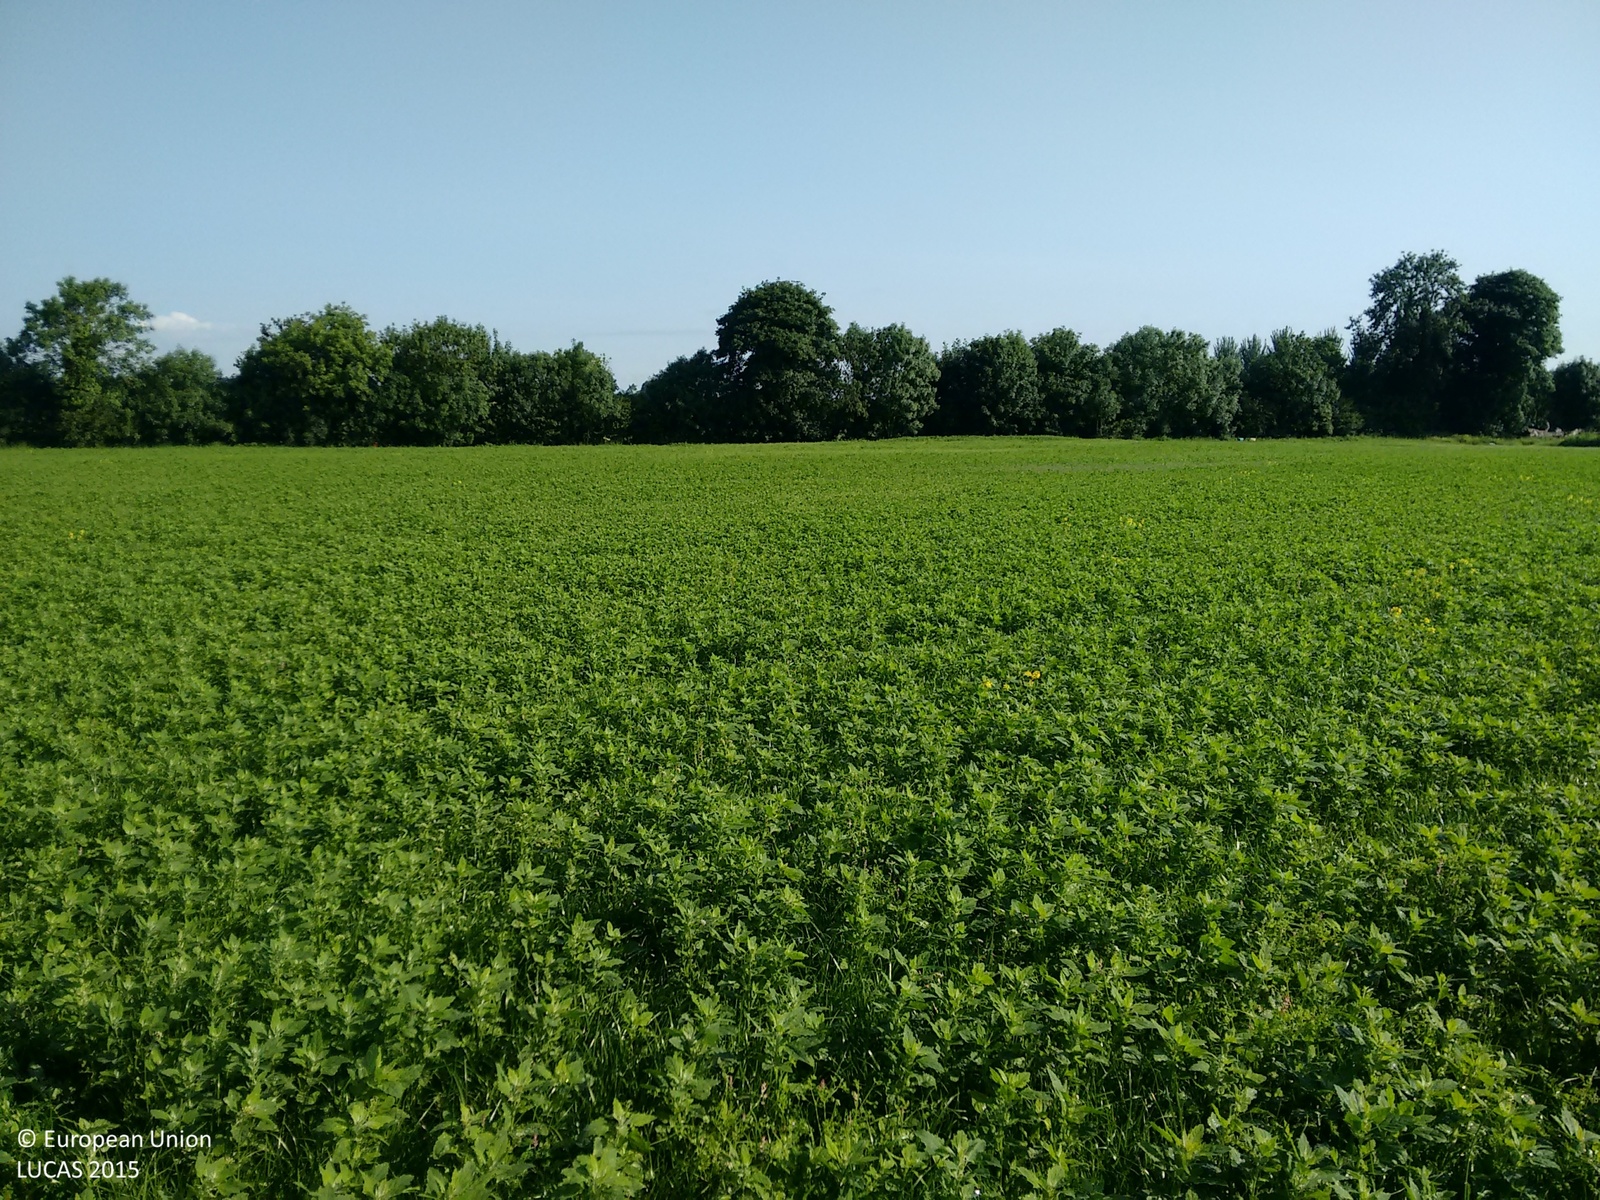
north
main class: Cropland
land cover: Temporary grasslands
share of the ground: > 75 %
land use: Agriculture (excluding fallow land and kitchen gardens)
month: July
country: IE
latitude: 52.5782
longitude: -7.7122
